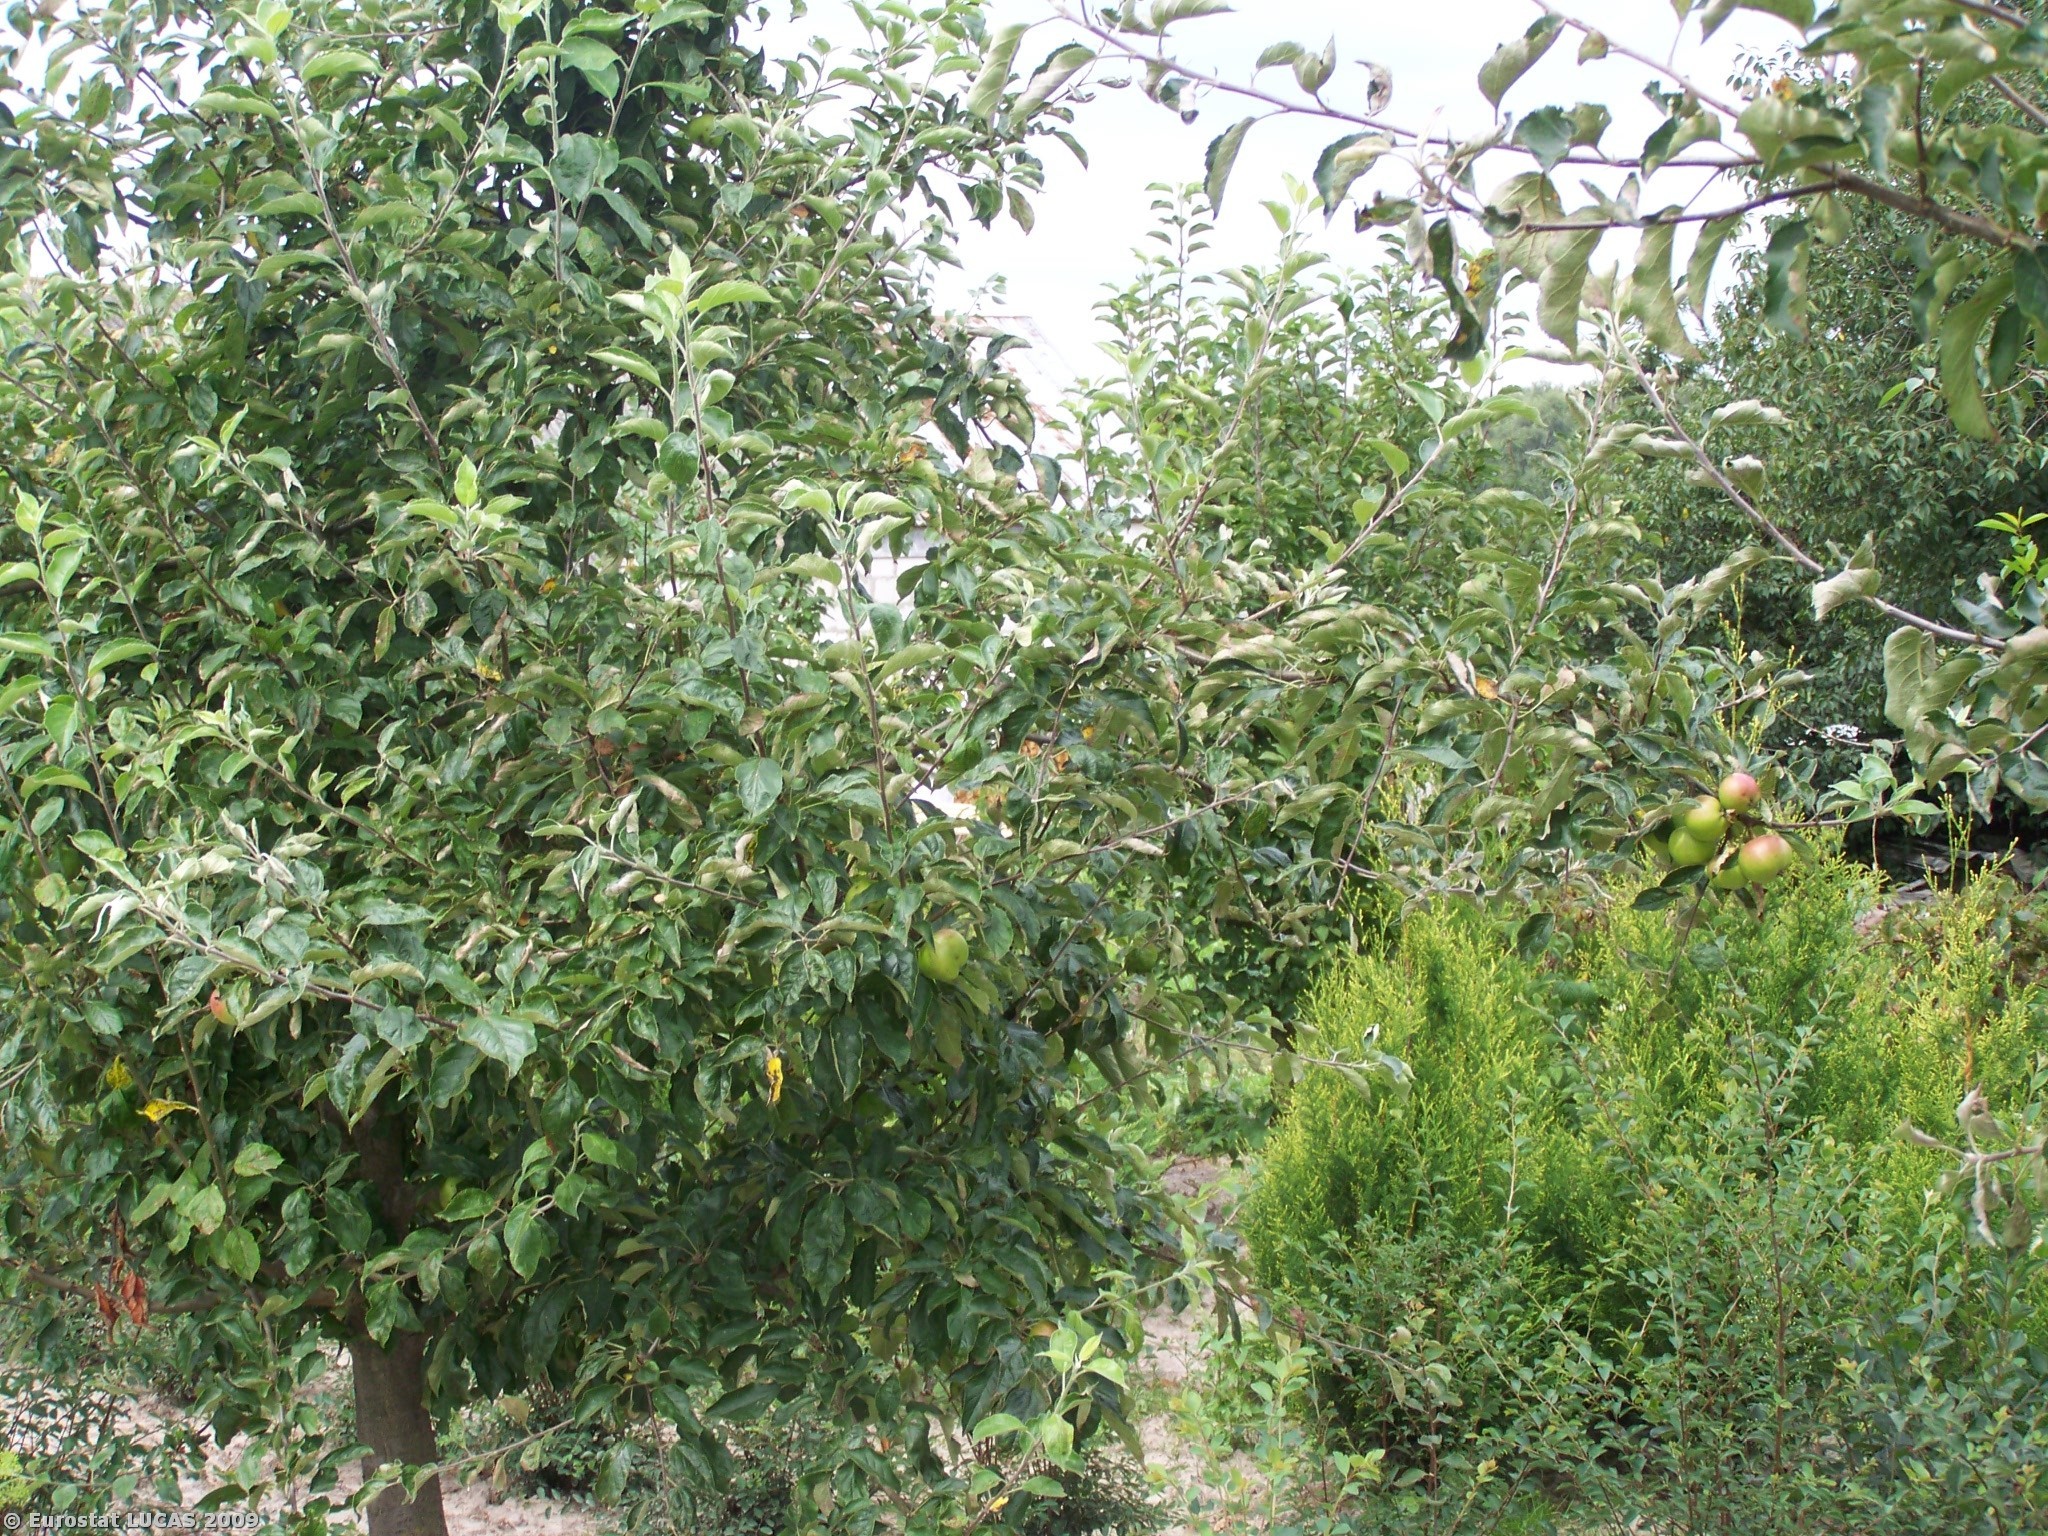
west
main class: Cropland
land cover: Other fresh vegetables
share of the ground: > 75 %
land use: Agriculture (excluding fallow land and kitchen gardens)
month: July
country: PL
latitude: 51.4345
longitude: 22.0417
